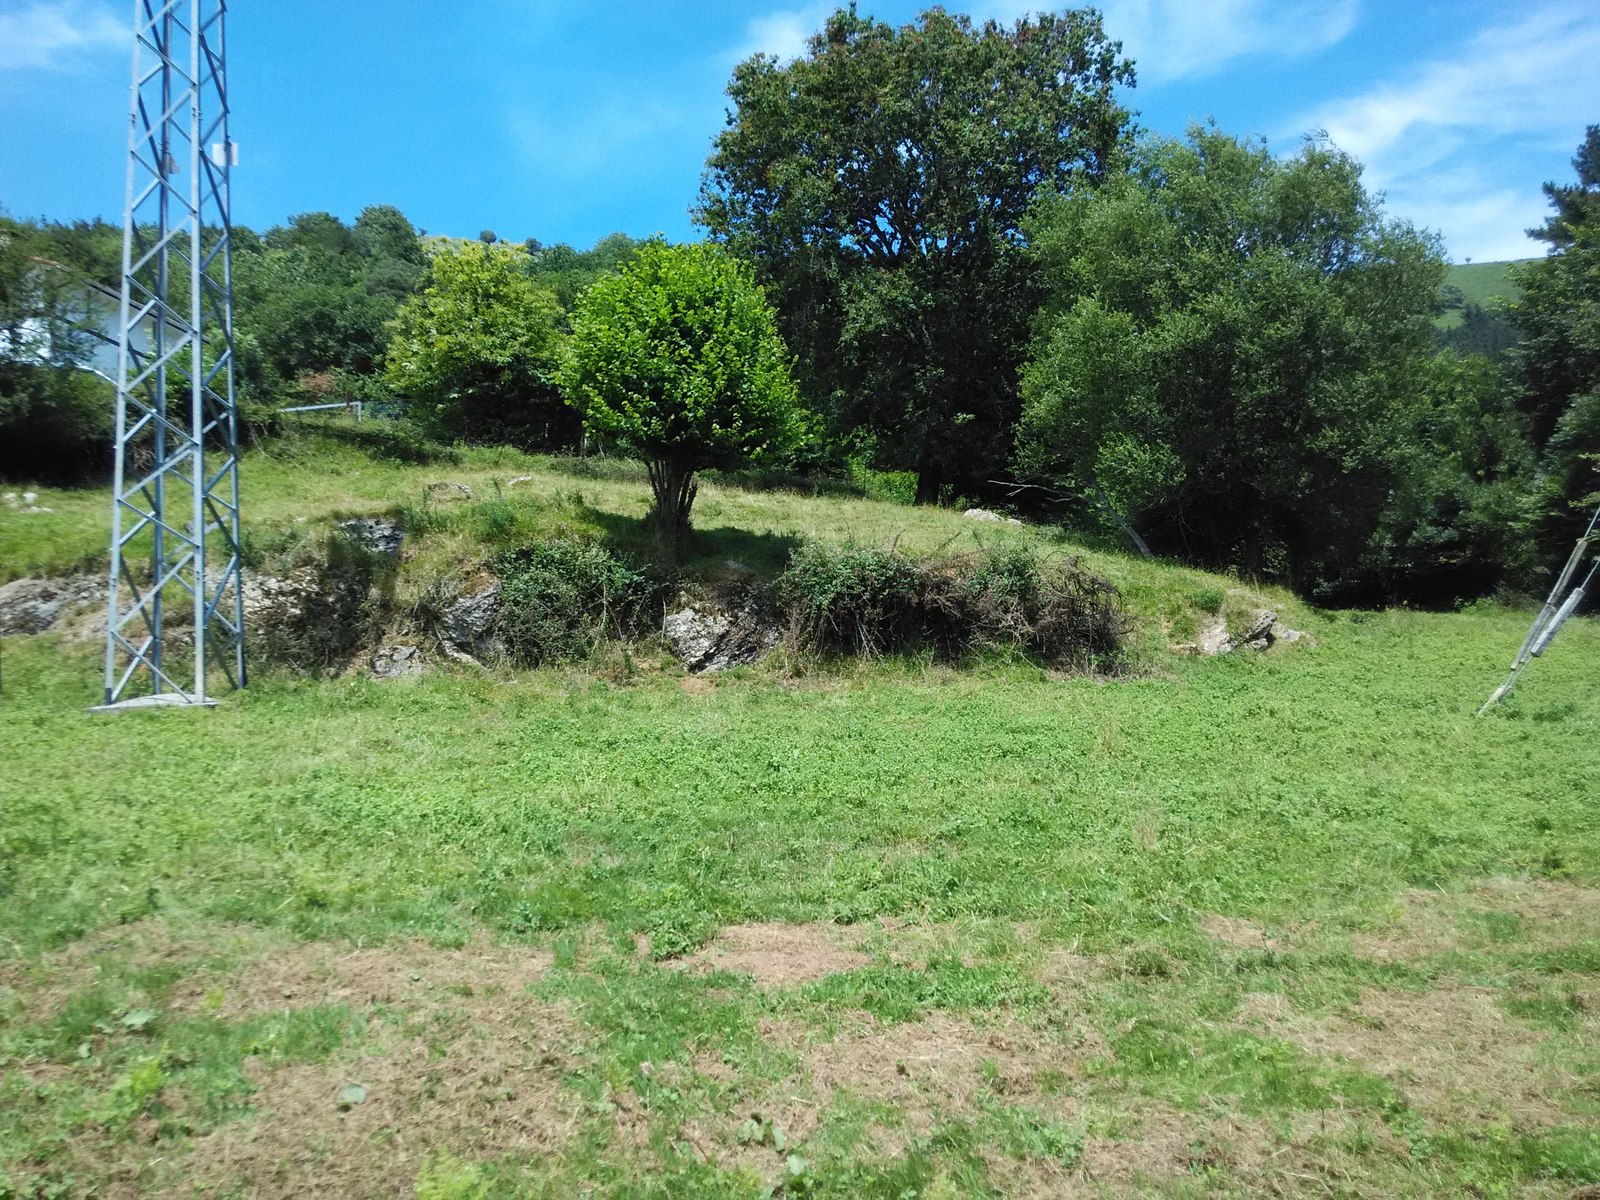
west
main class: Grassland
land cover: Grassland without tree/shrub cover
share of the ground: > 75 %
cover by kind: herbaceous plants 100 %
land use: Agriculture (excluding fallow land and kitchen gardens)
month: July
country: ES
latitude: 43.1852
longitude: -2.2421
